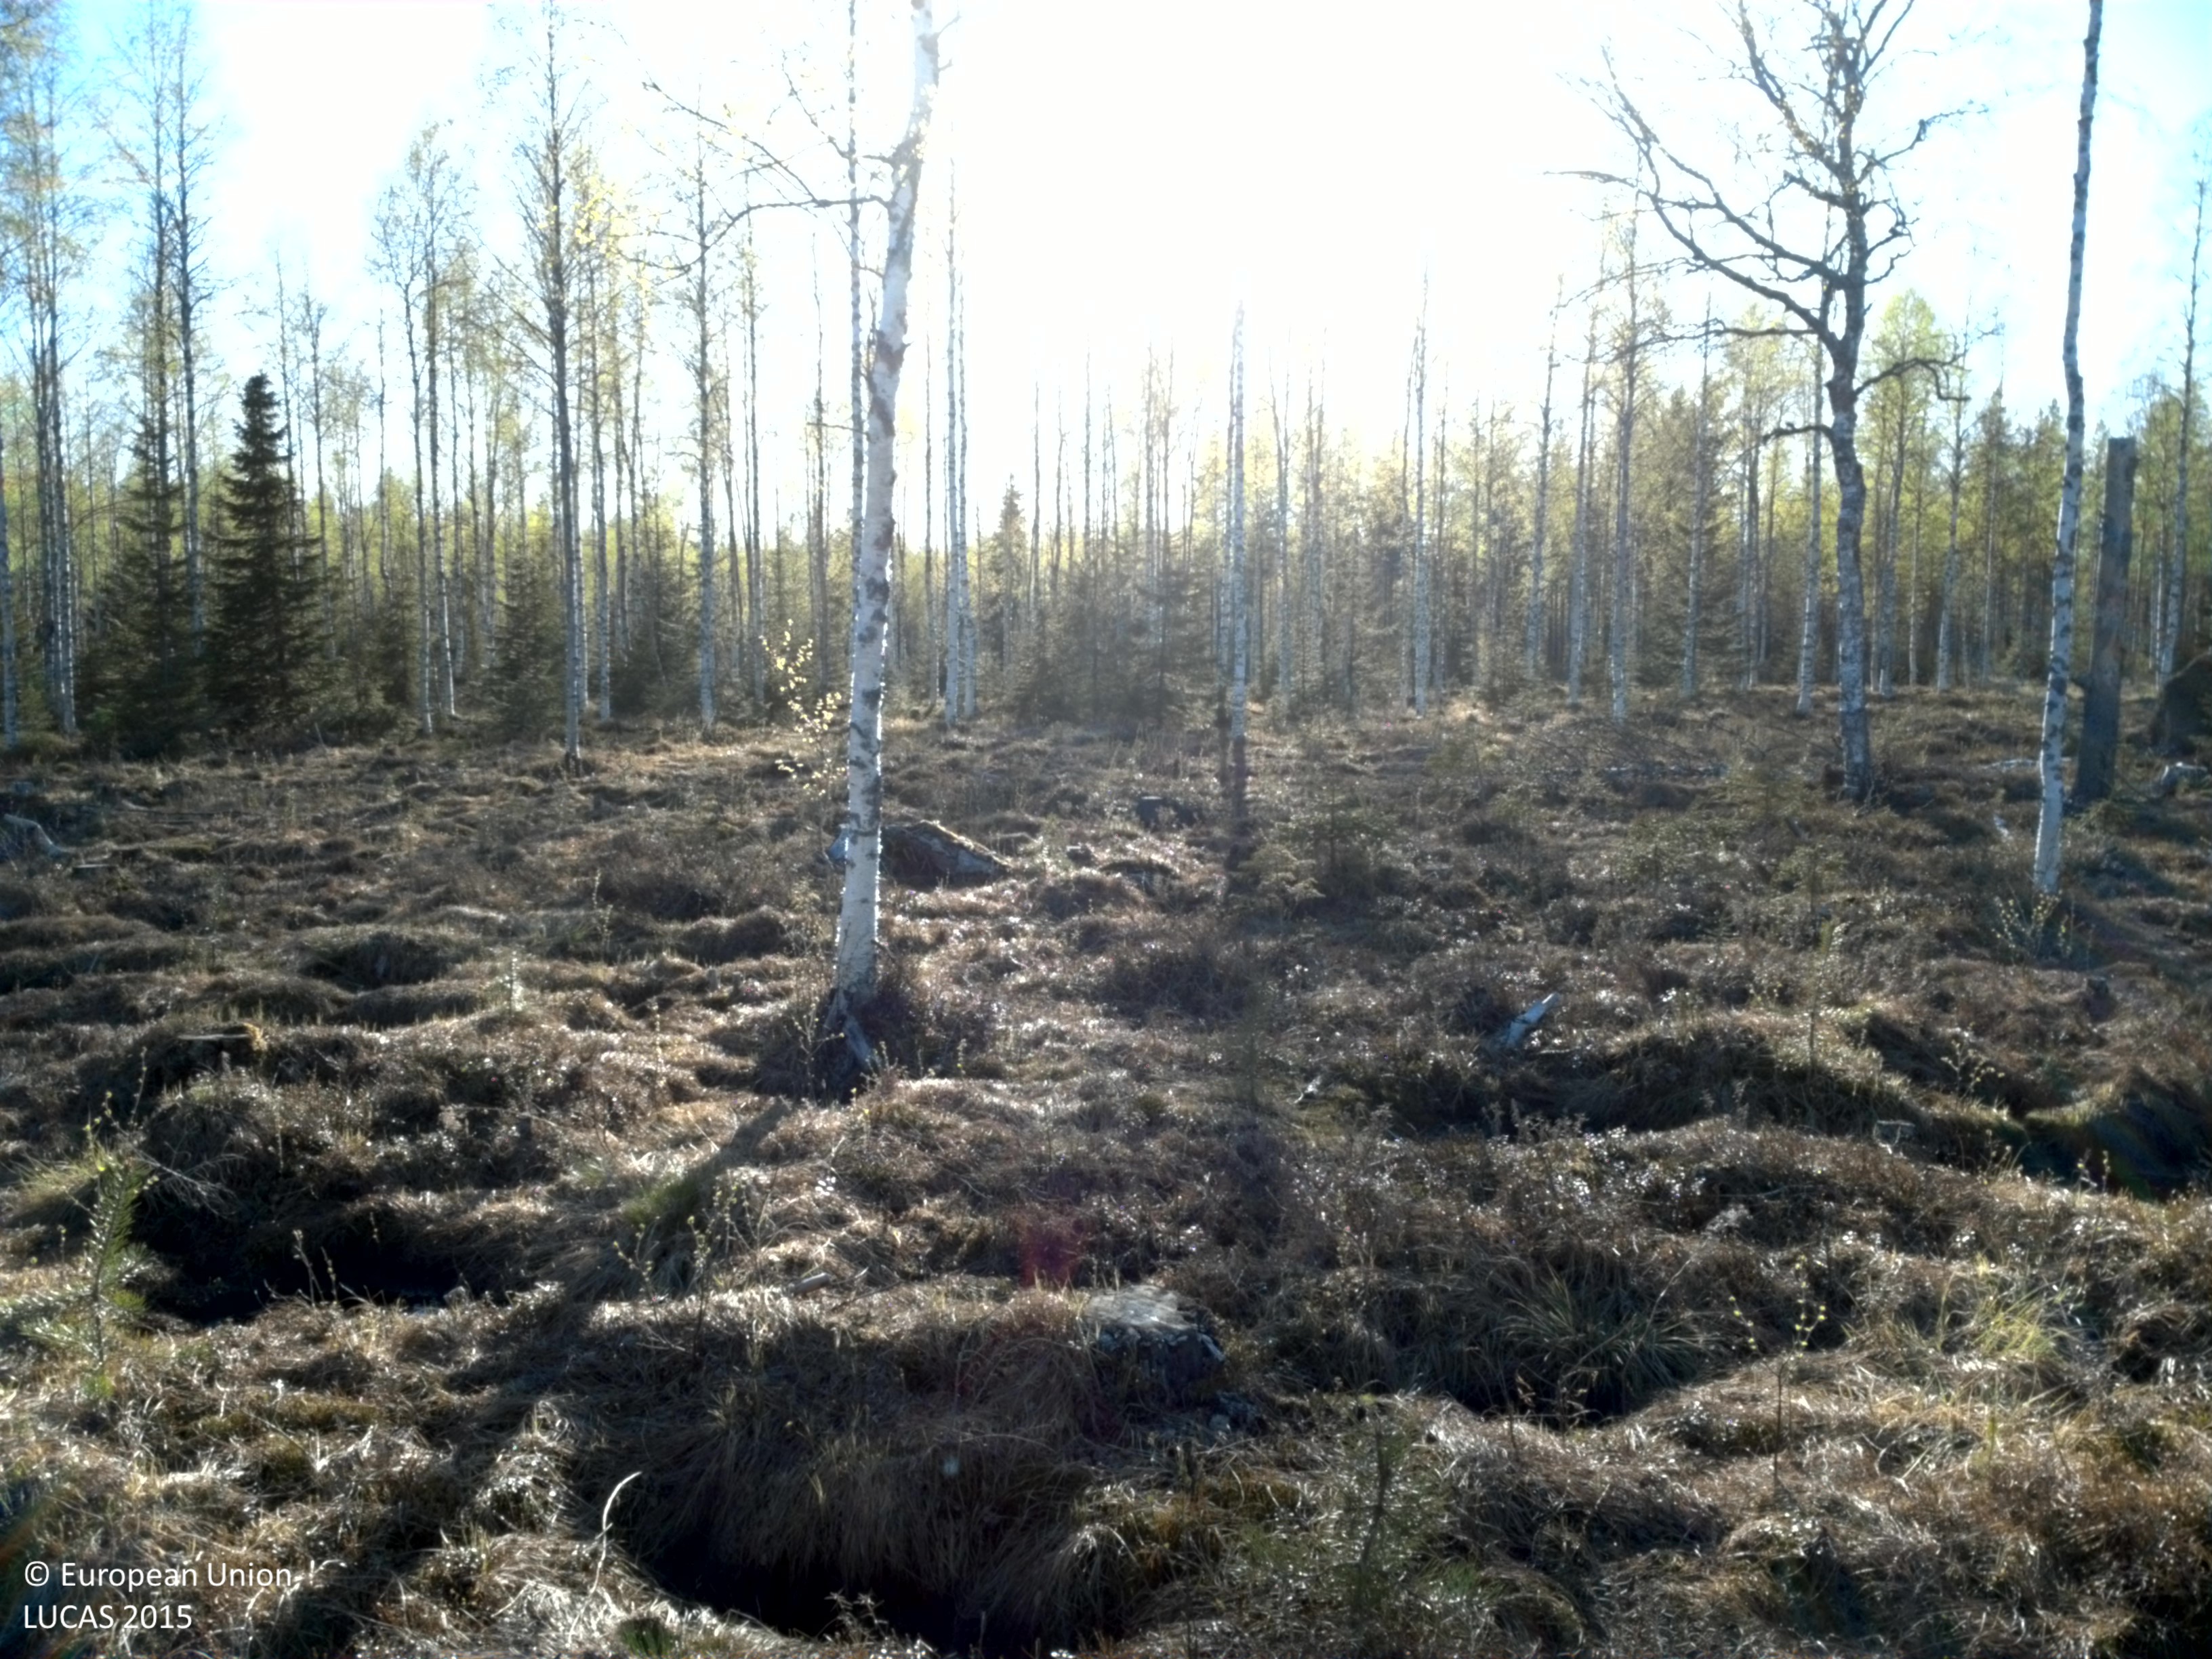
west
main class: Shrubland
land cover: Shrubland with sparse tree cover
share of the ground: 50 - 75 %
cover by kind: shrubs 65 %, herbaceous plants 30 %, broadleaved forest trees 5 %
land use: Forestry
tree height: > 5 m
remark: Clear cut
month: May
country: SE
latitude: 66.0530
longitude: 23.3907
